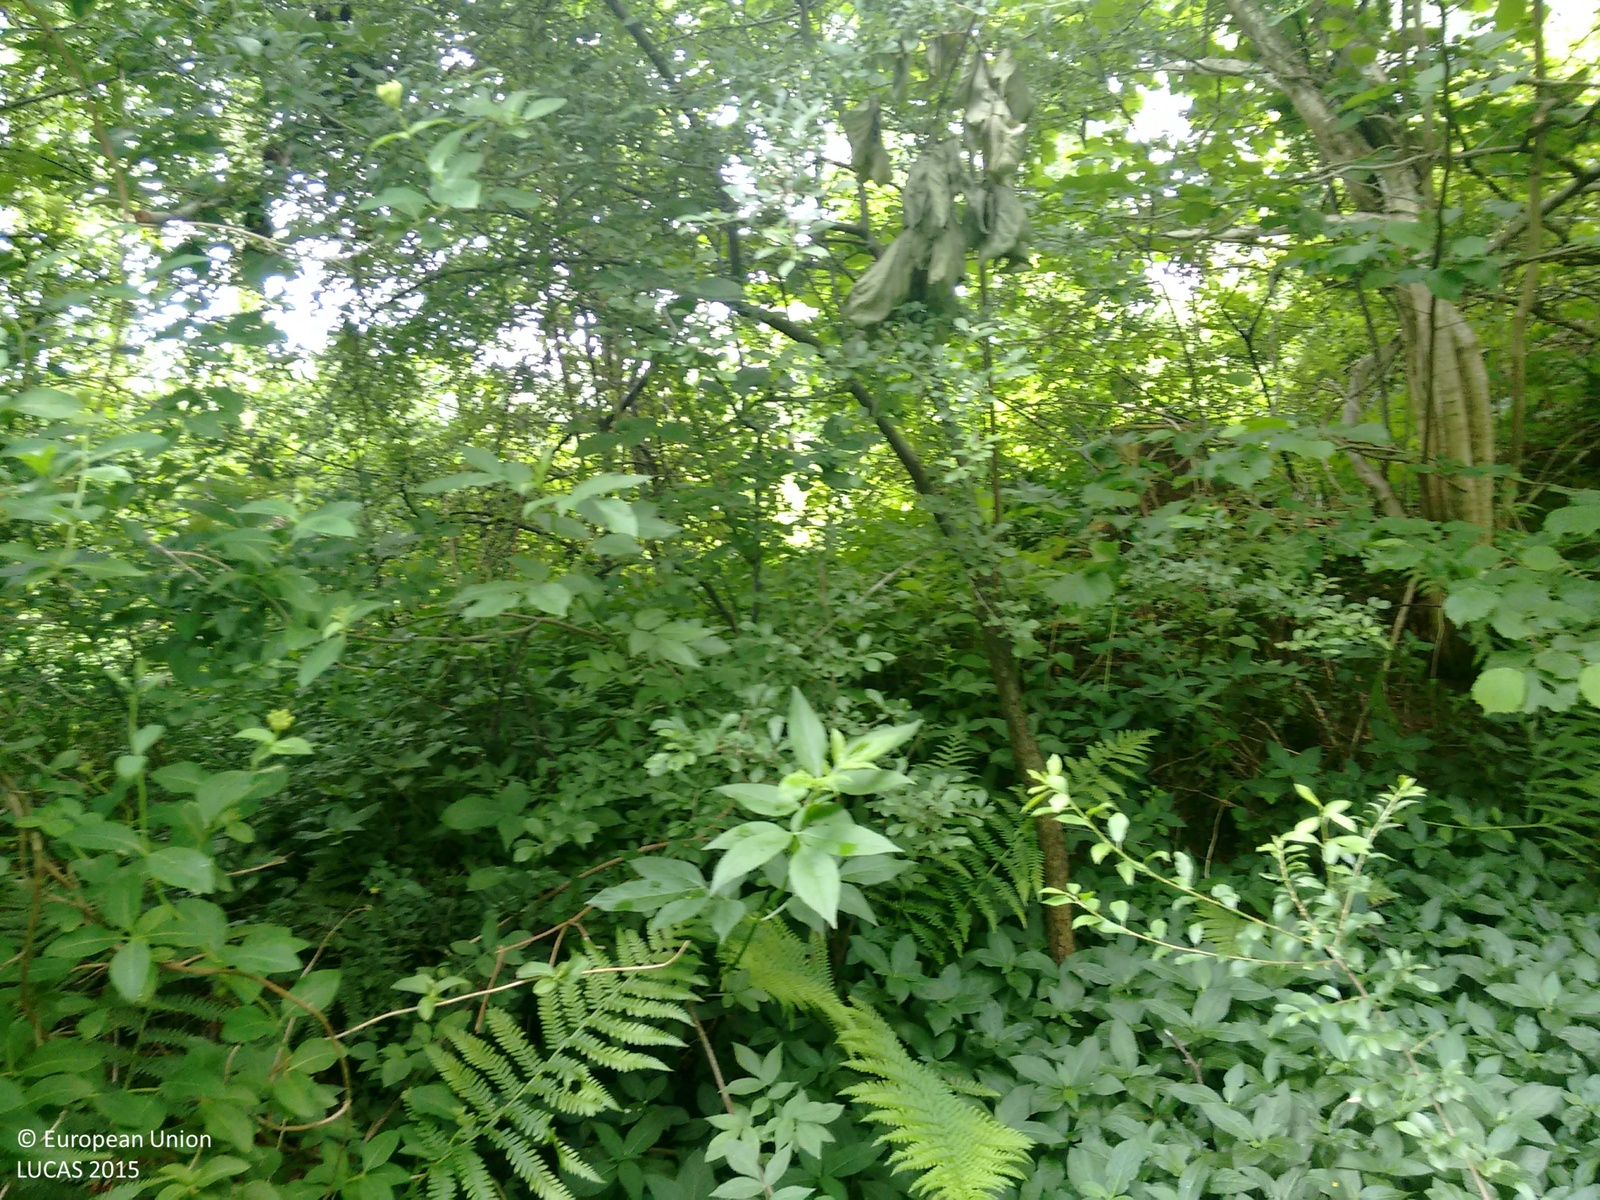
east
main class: Woodland
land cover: Broadleaved woodland
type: mesophytic deciduous forest
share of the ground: > 75 %
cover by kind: broadleaved forest trees 80 %, coniferous forest trees 20 %
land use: Forestry
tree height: > 5 m
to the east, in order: Broadleaved woodland; Fences; Pine dominated mixed woodland; Grass margins; Paved roads, cycling and walking lanes; Grass margins; Broadleaved woodland
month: June
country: GB
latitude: 54.4307
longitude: -1.1271
